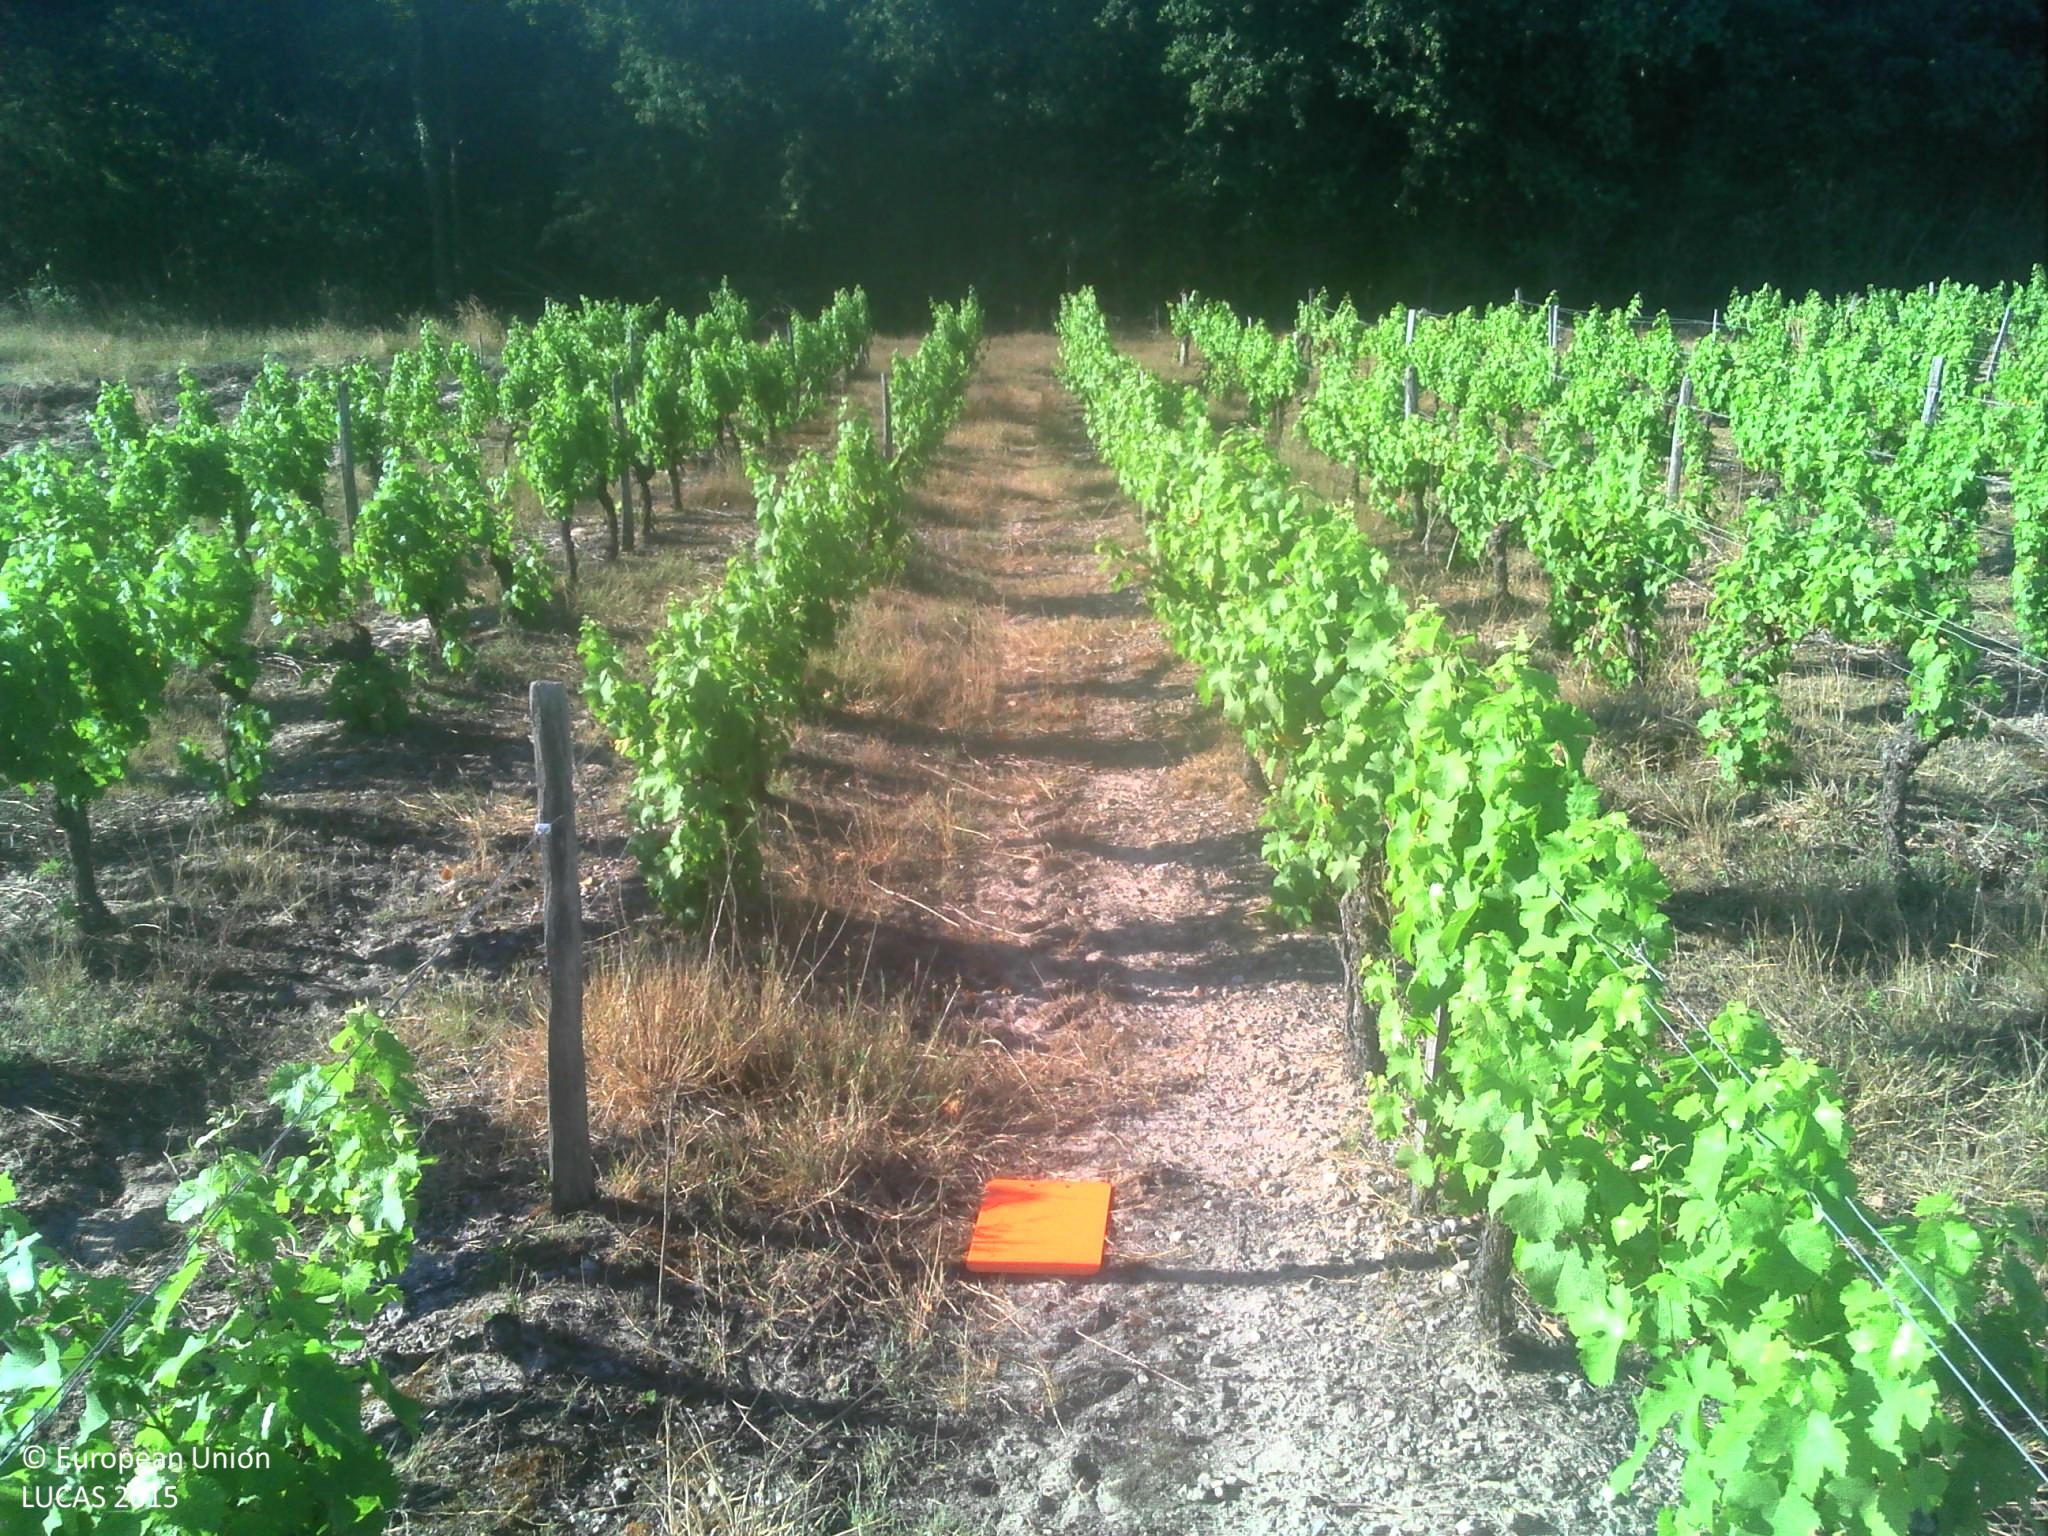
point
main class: Cropland
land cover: Vineyards
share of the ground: 25 - 50 %
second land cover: Spontaneously vegetated surfaces
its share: > 75 %
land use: Agriculture (excluding fallow land and kitchen gardens)
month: June
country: FR
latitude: 47.3342
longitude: 1.5039
